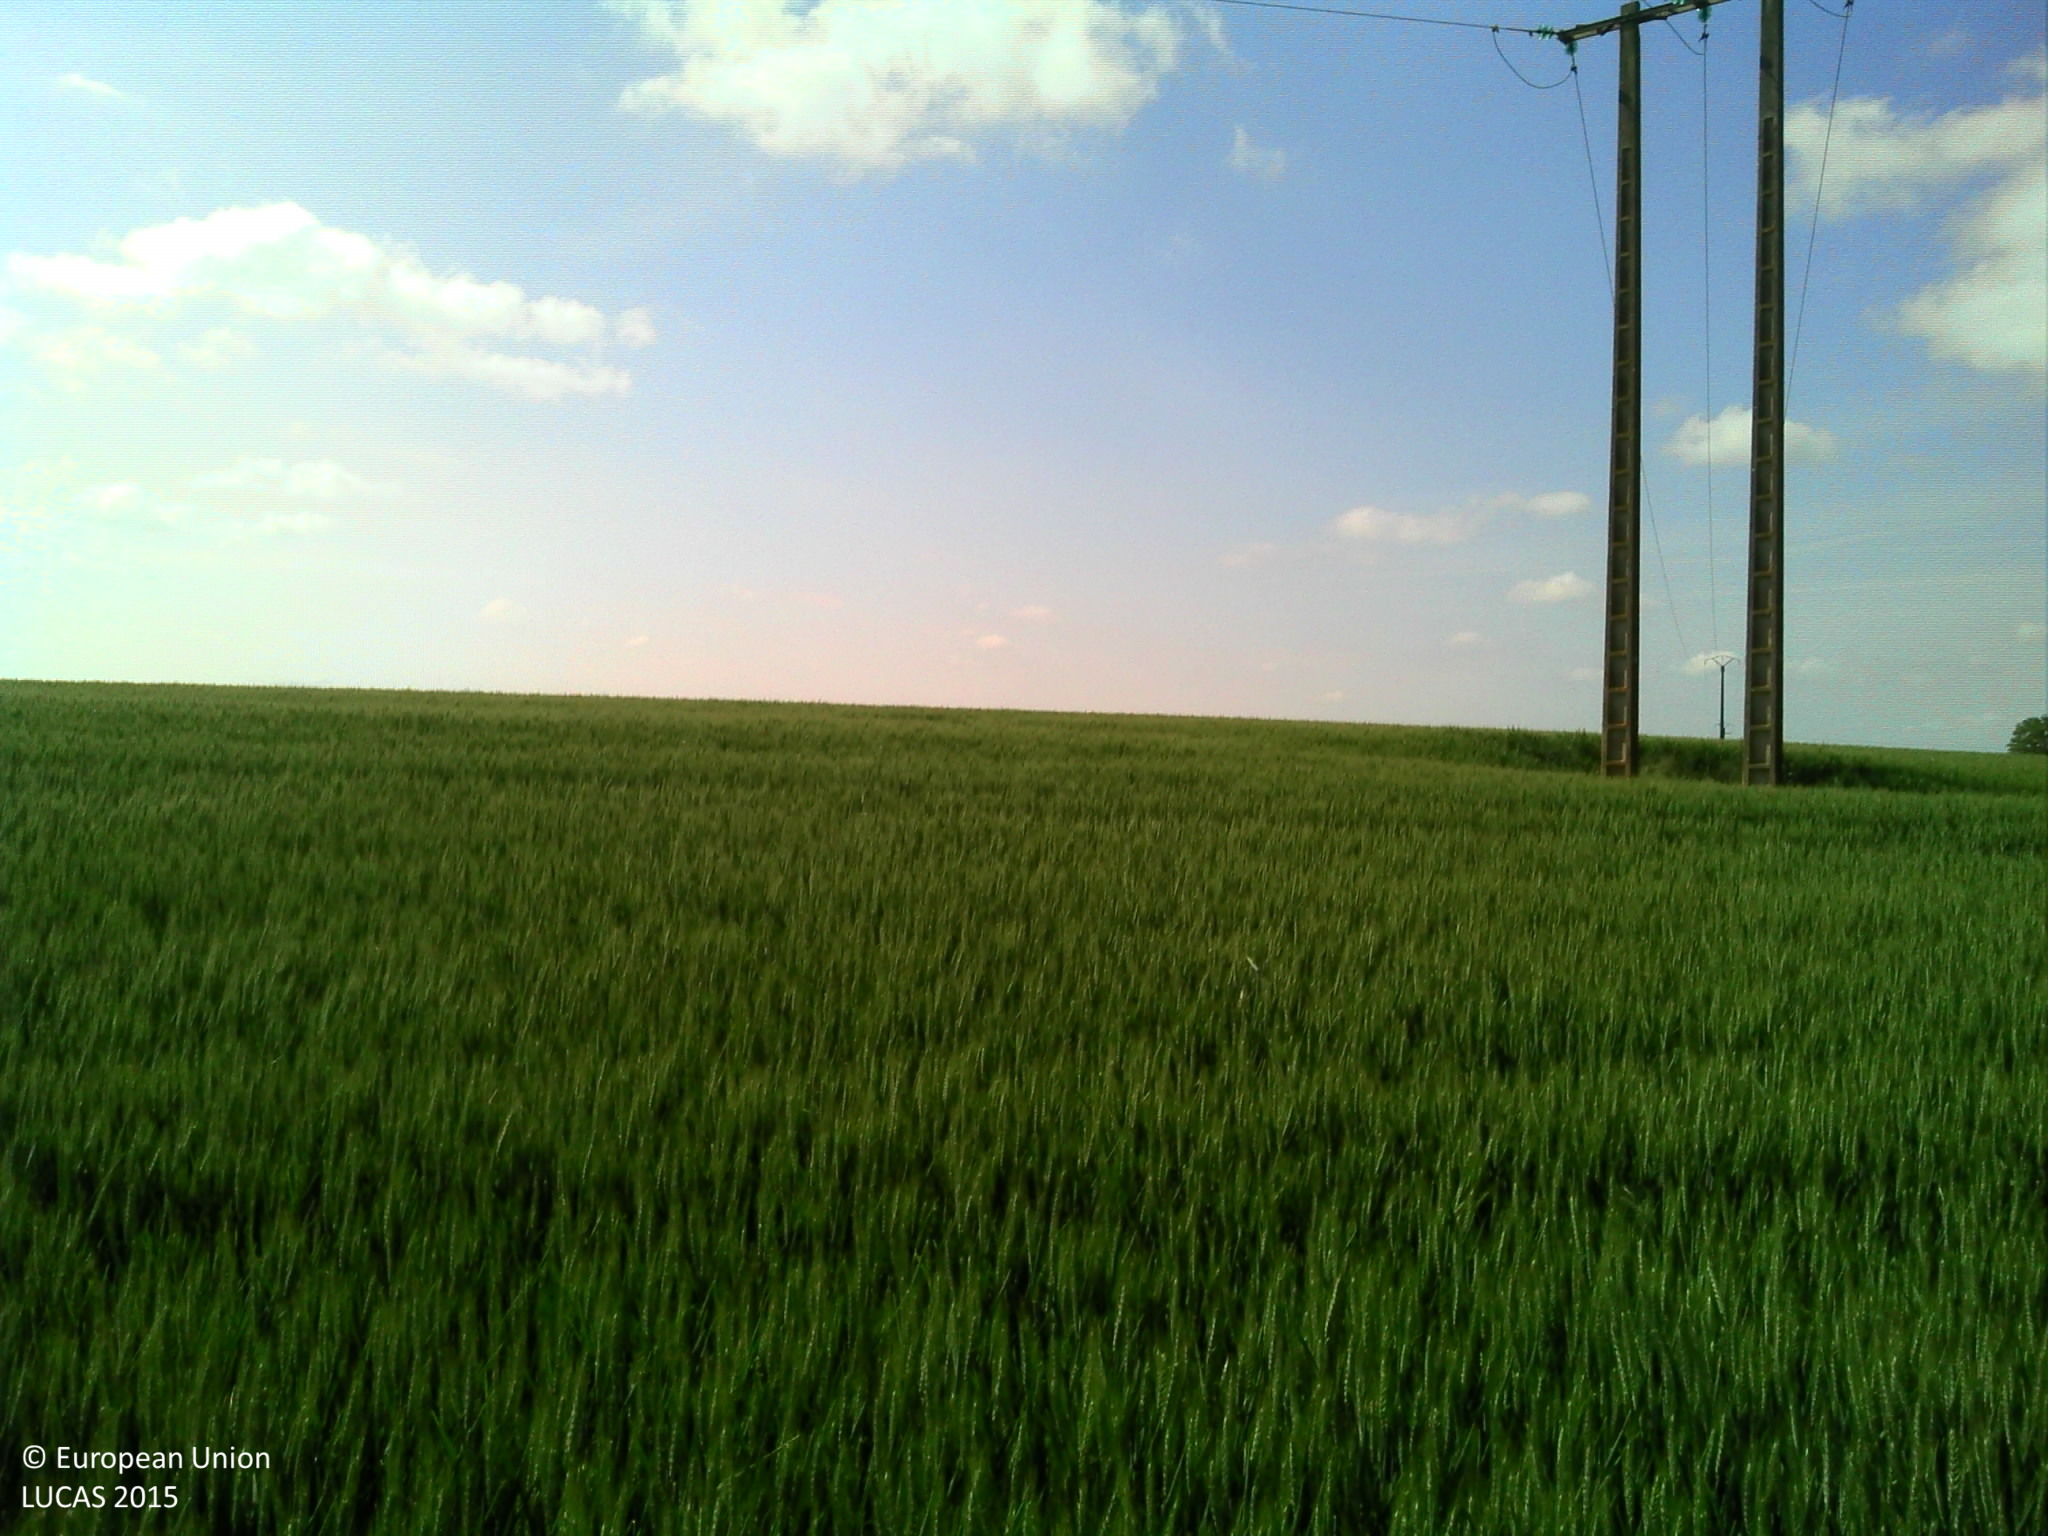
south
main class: Cropland
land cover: Common wheat
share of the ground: > 75 %
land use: Agriculture (excluding fallow land and kitchen gardens)
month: May
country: FR
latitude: 47.4346
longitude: 5.2141
